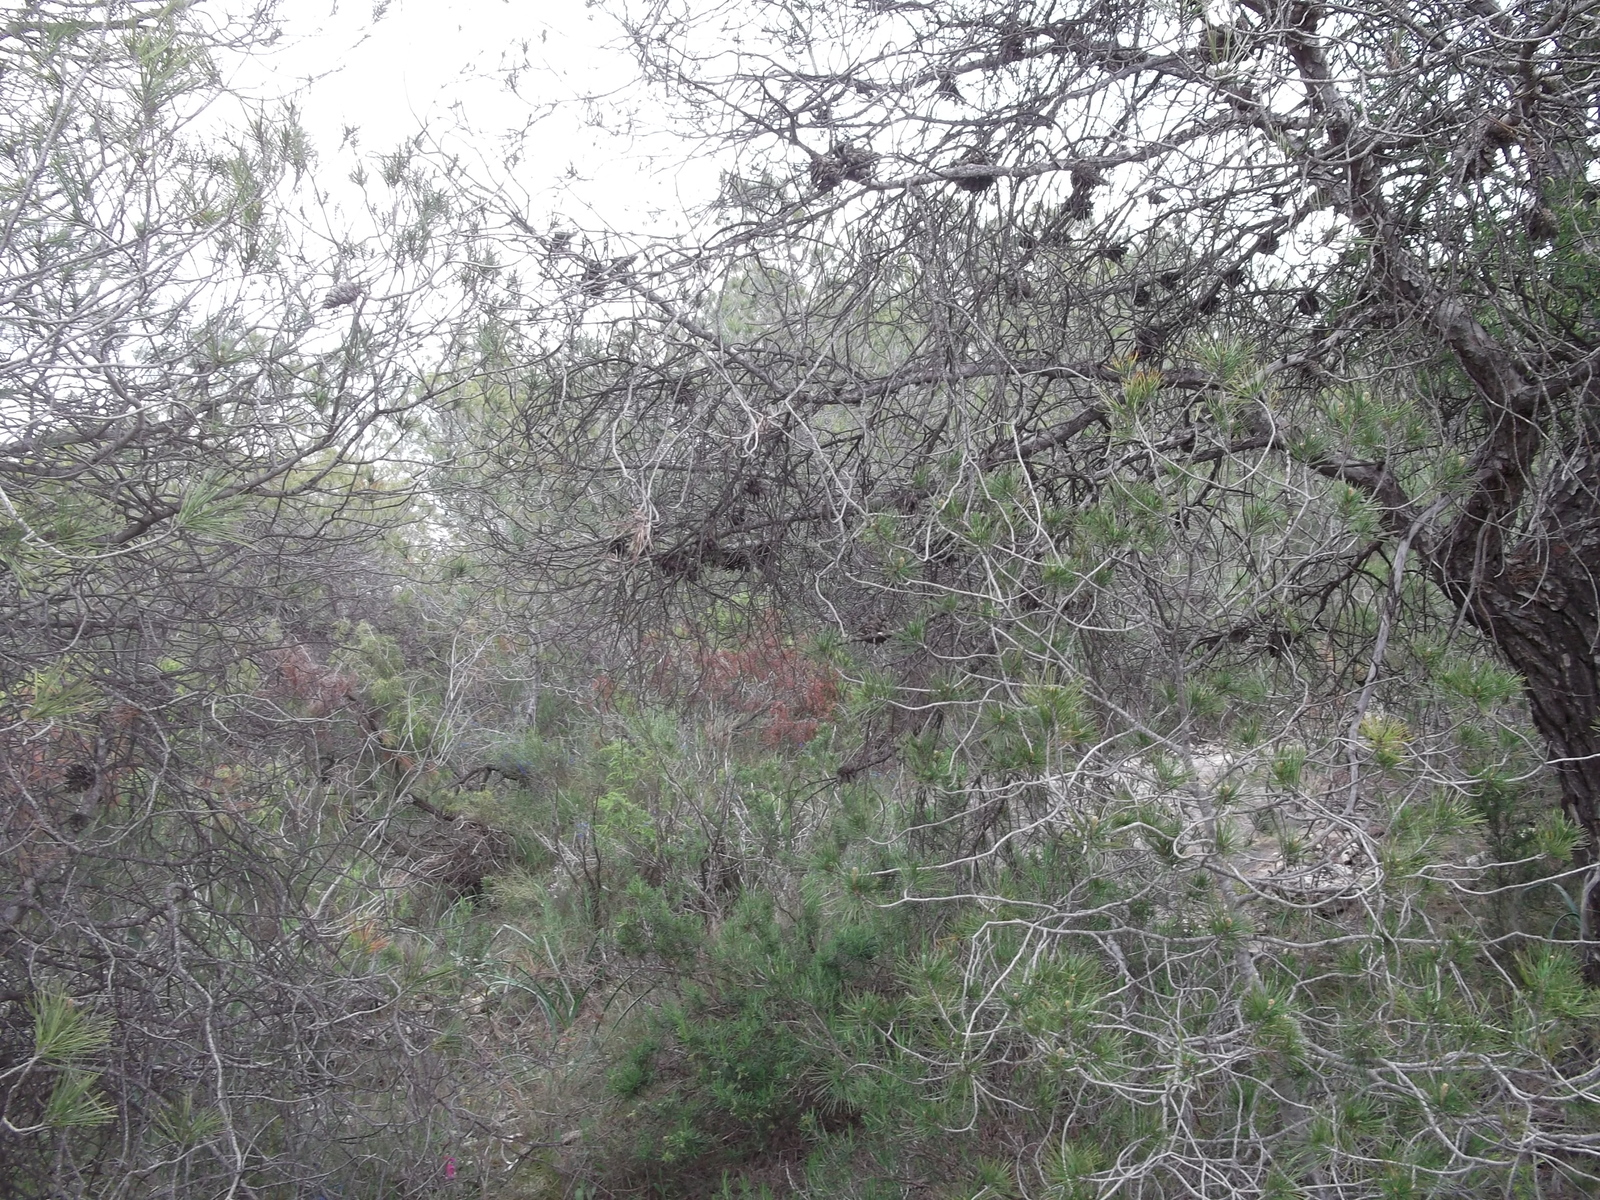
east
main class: Woodland
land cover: Pine dominated coniferous woodland
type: coniferous forest of the mediterranean region
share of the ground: 25 - 50 %
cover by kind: shrubs 70 %, coniferous forest trees 30 %
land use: Forestry
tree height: > 5 m
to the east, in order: Pine dominated coniferous woodland; Nuts trees
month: April
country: ES
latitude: 37.9425
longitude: -1.5121
